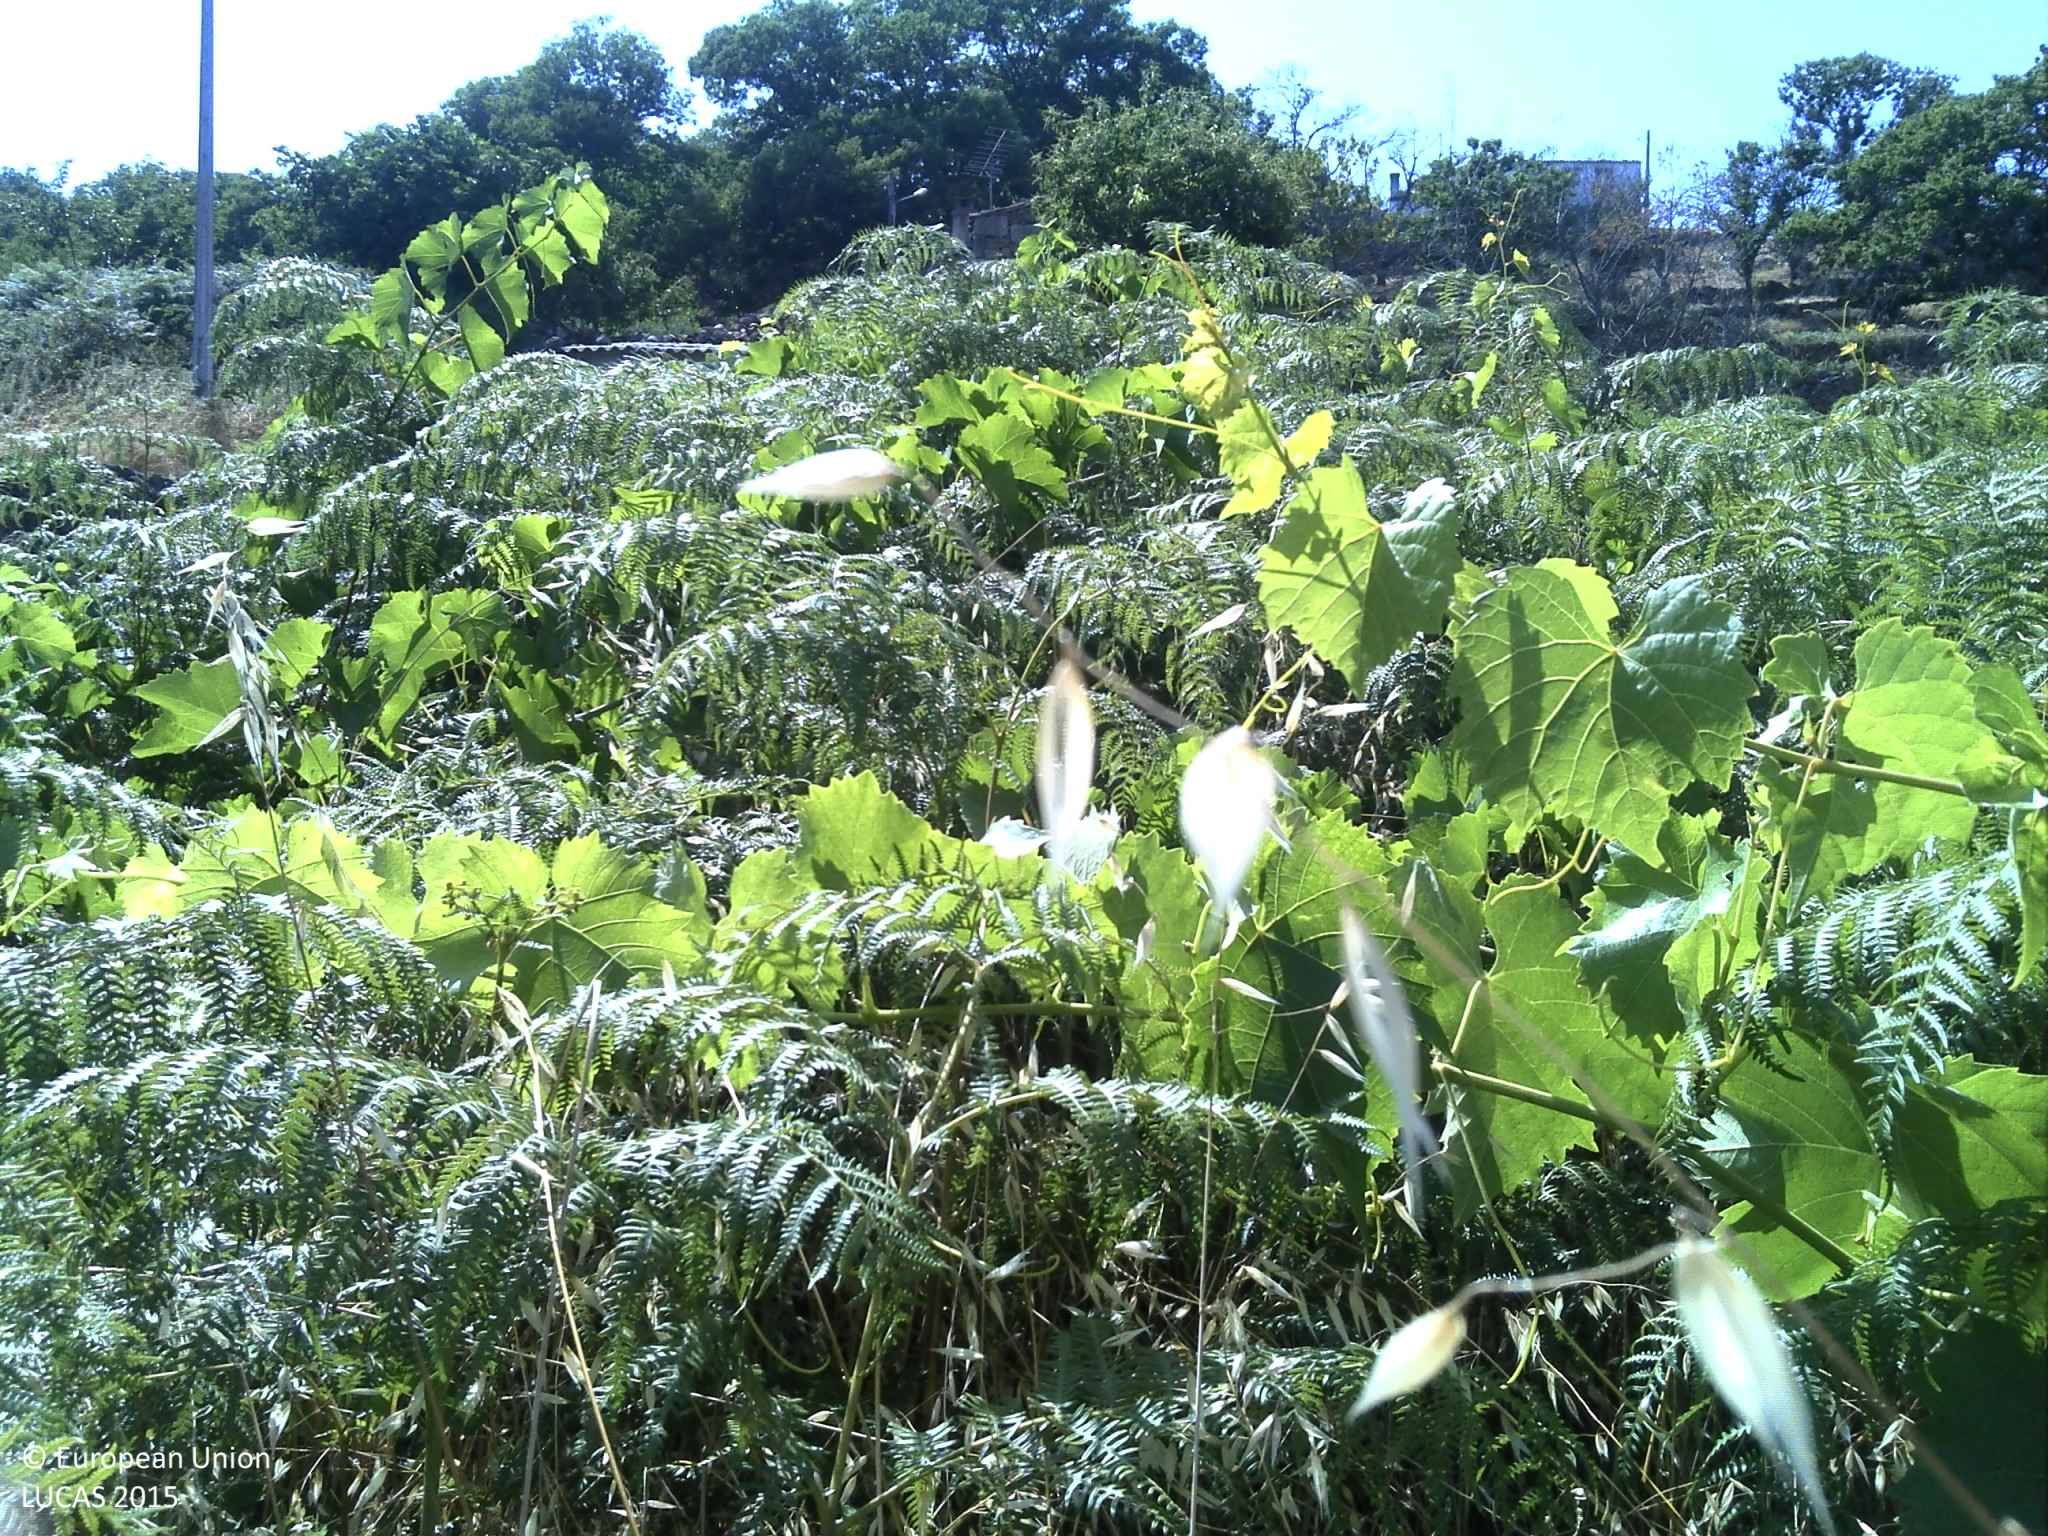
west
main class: Cropland
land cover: Vineyards
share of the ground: 10 - 25 %
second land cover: Spontaneously vegetated surfaces
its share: 25 - 50 %
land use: Abandoned areas
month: July
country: PT
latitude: 40.7959
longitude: -7.3327
